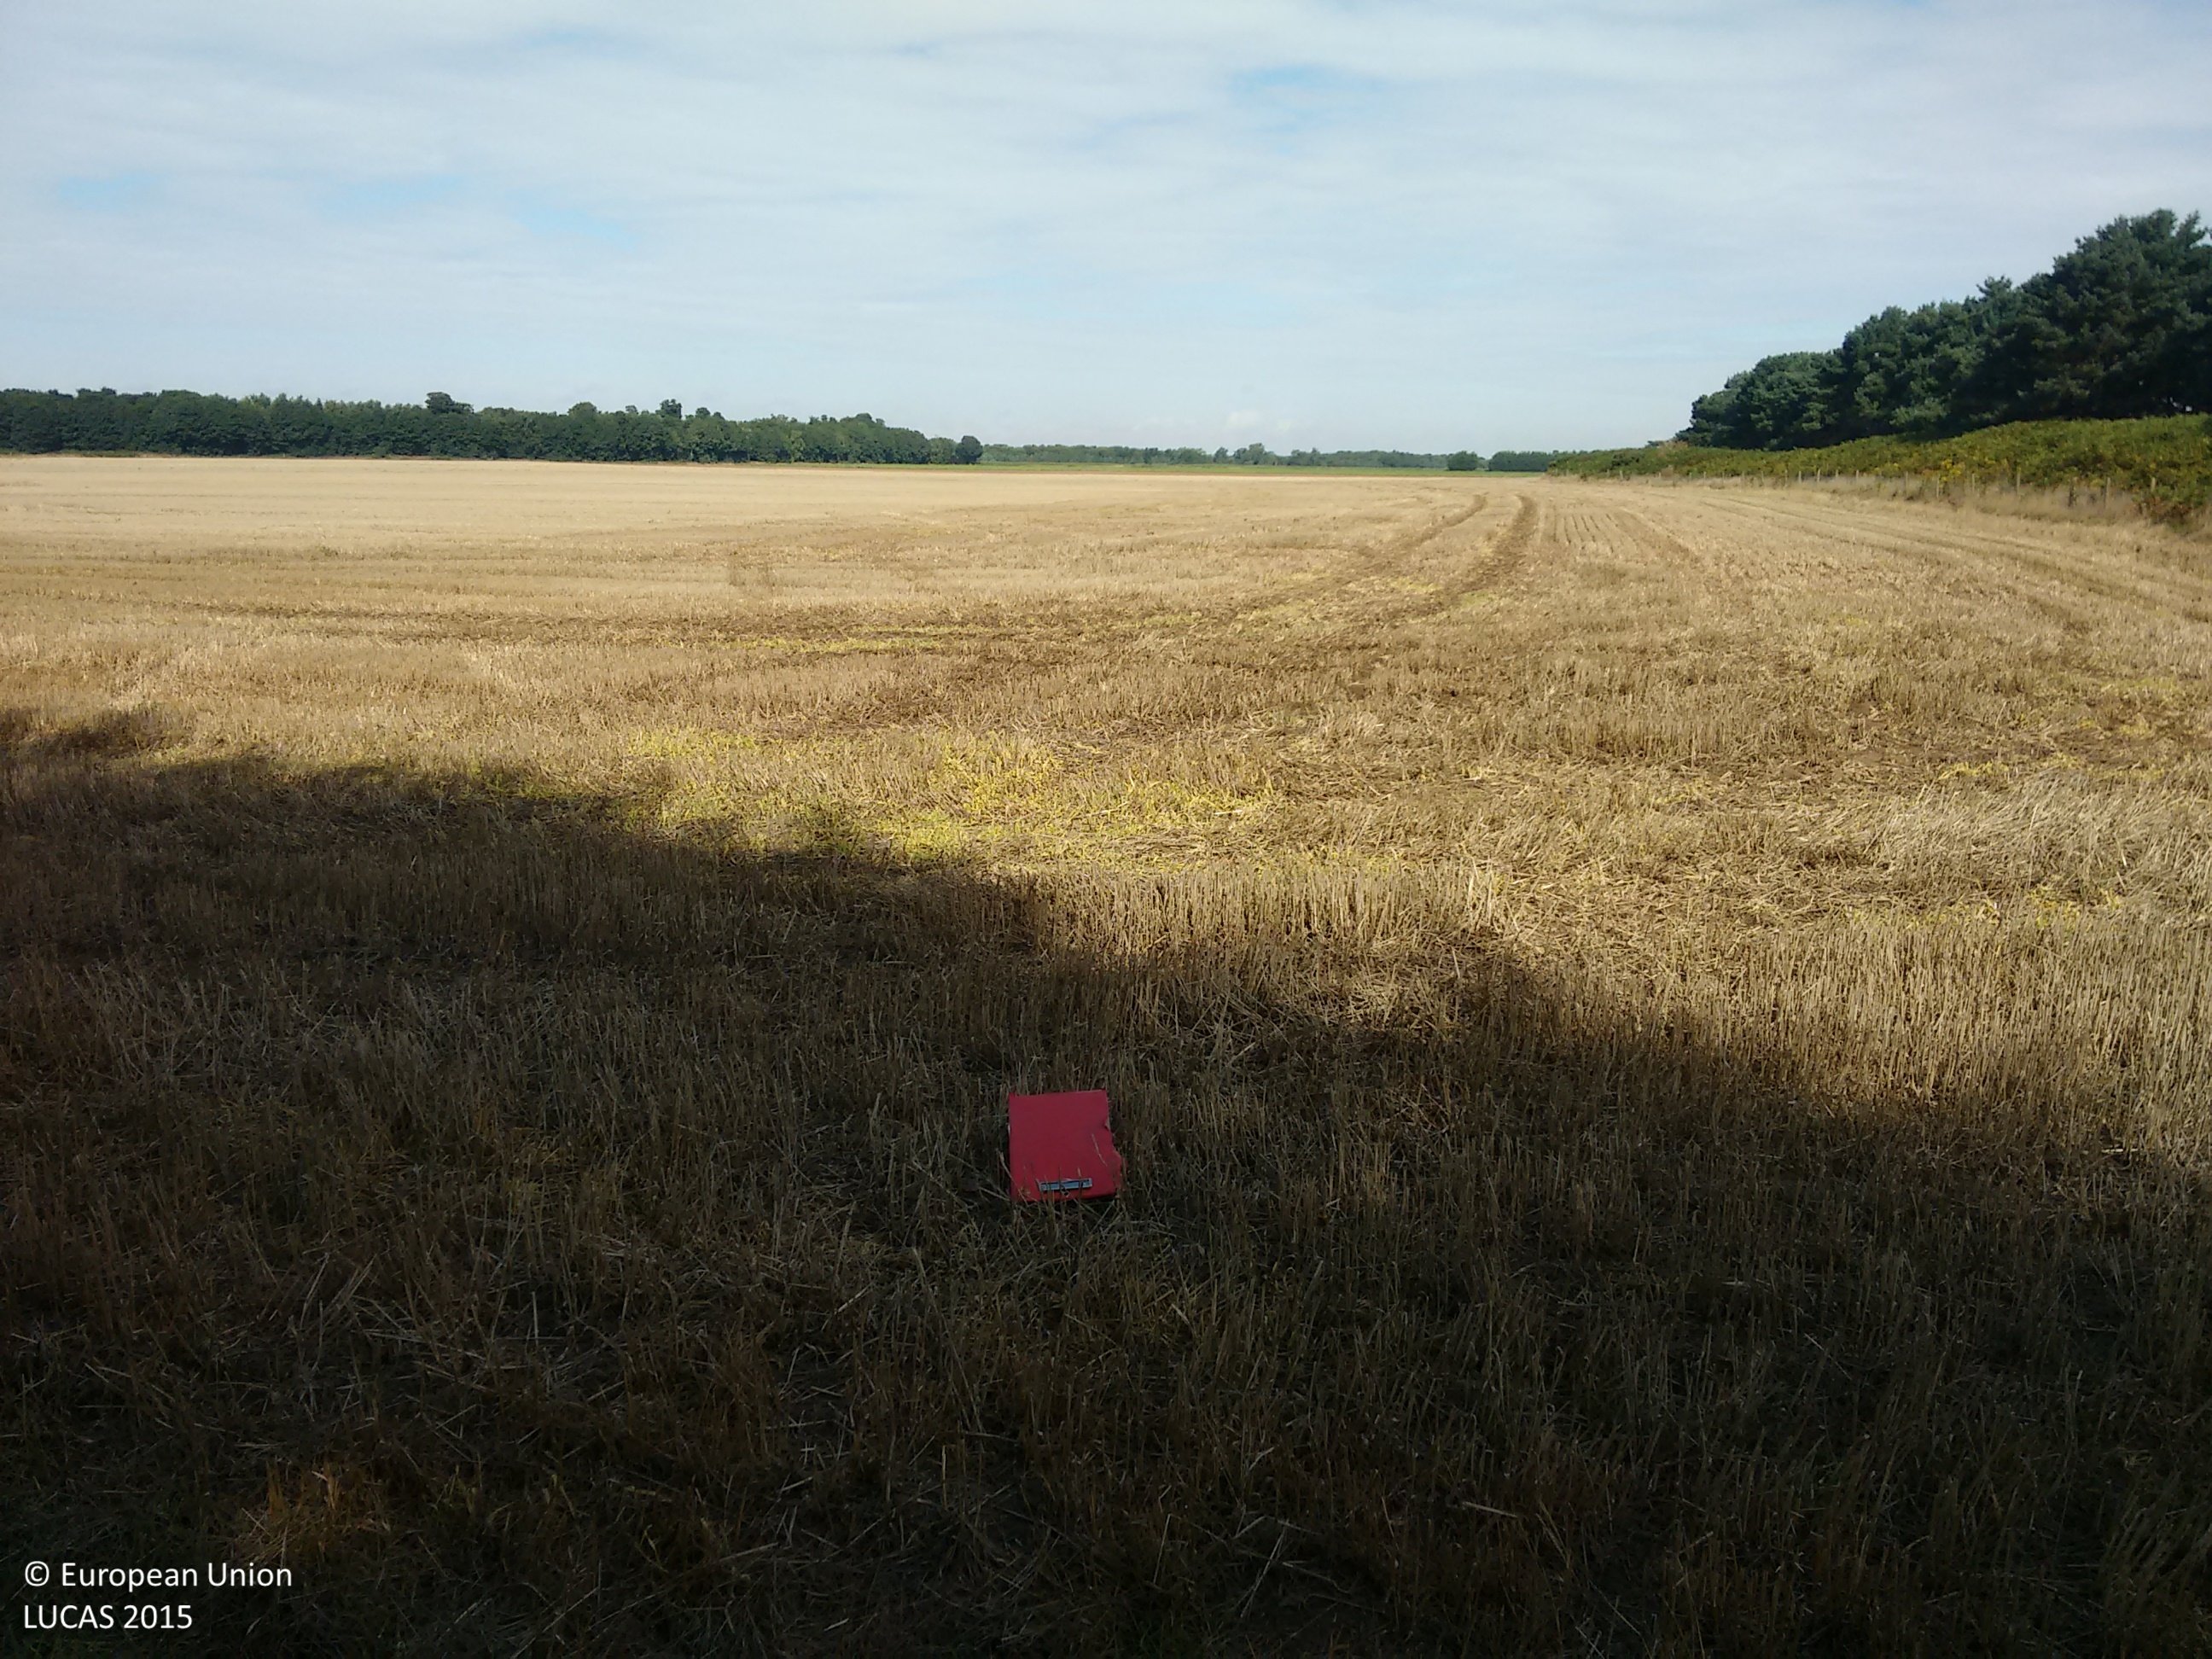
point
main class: Cropland
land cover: Barley
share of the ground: 50 - 75 %
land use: Agriculture (excluding fallow land and kitchen gardens)
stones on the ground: < 10 %
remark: Harvested field
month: August
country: GB
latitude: 52.0285
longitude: 1.3952
